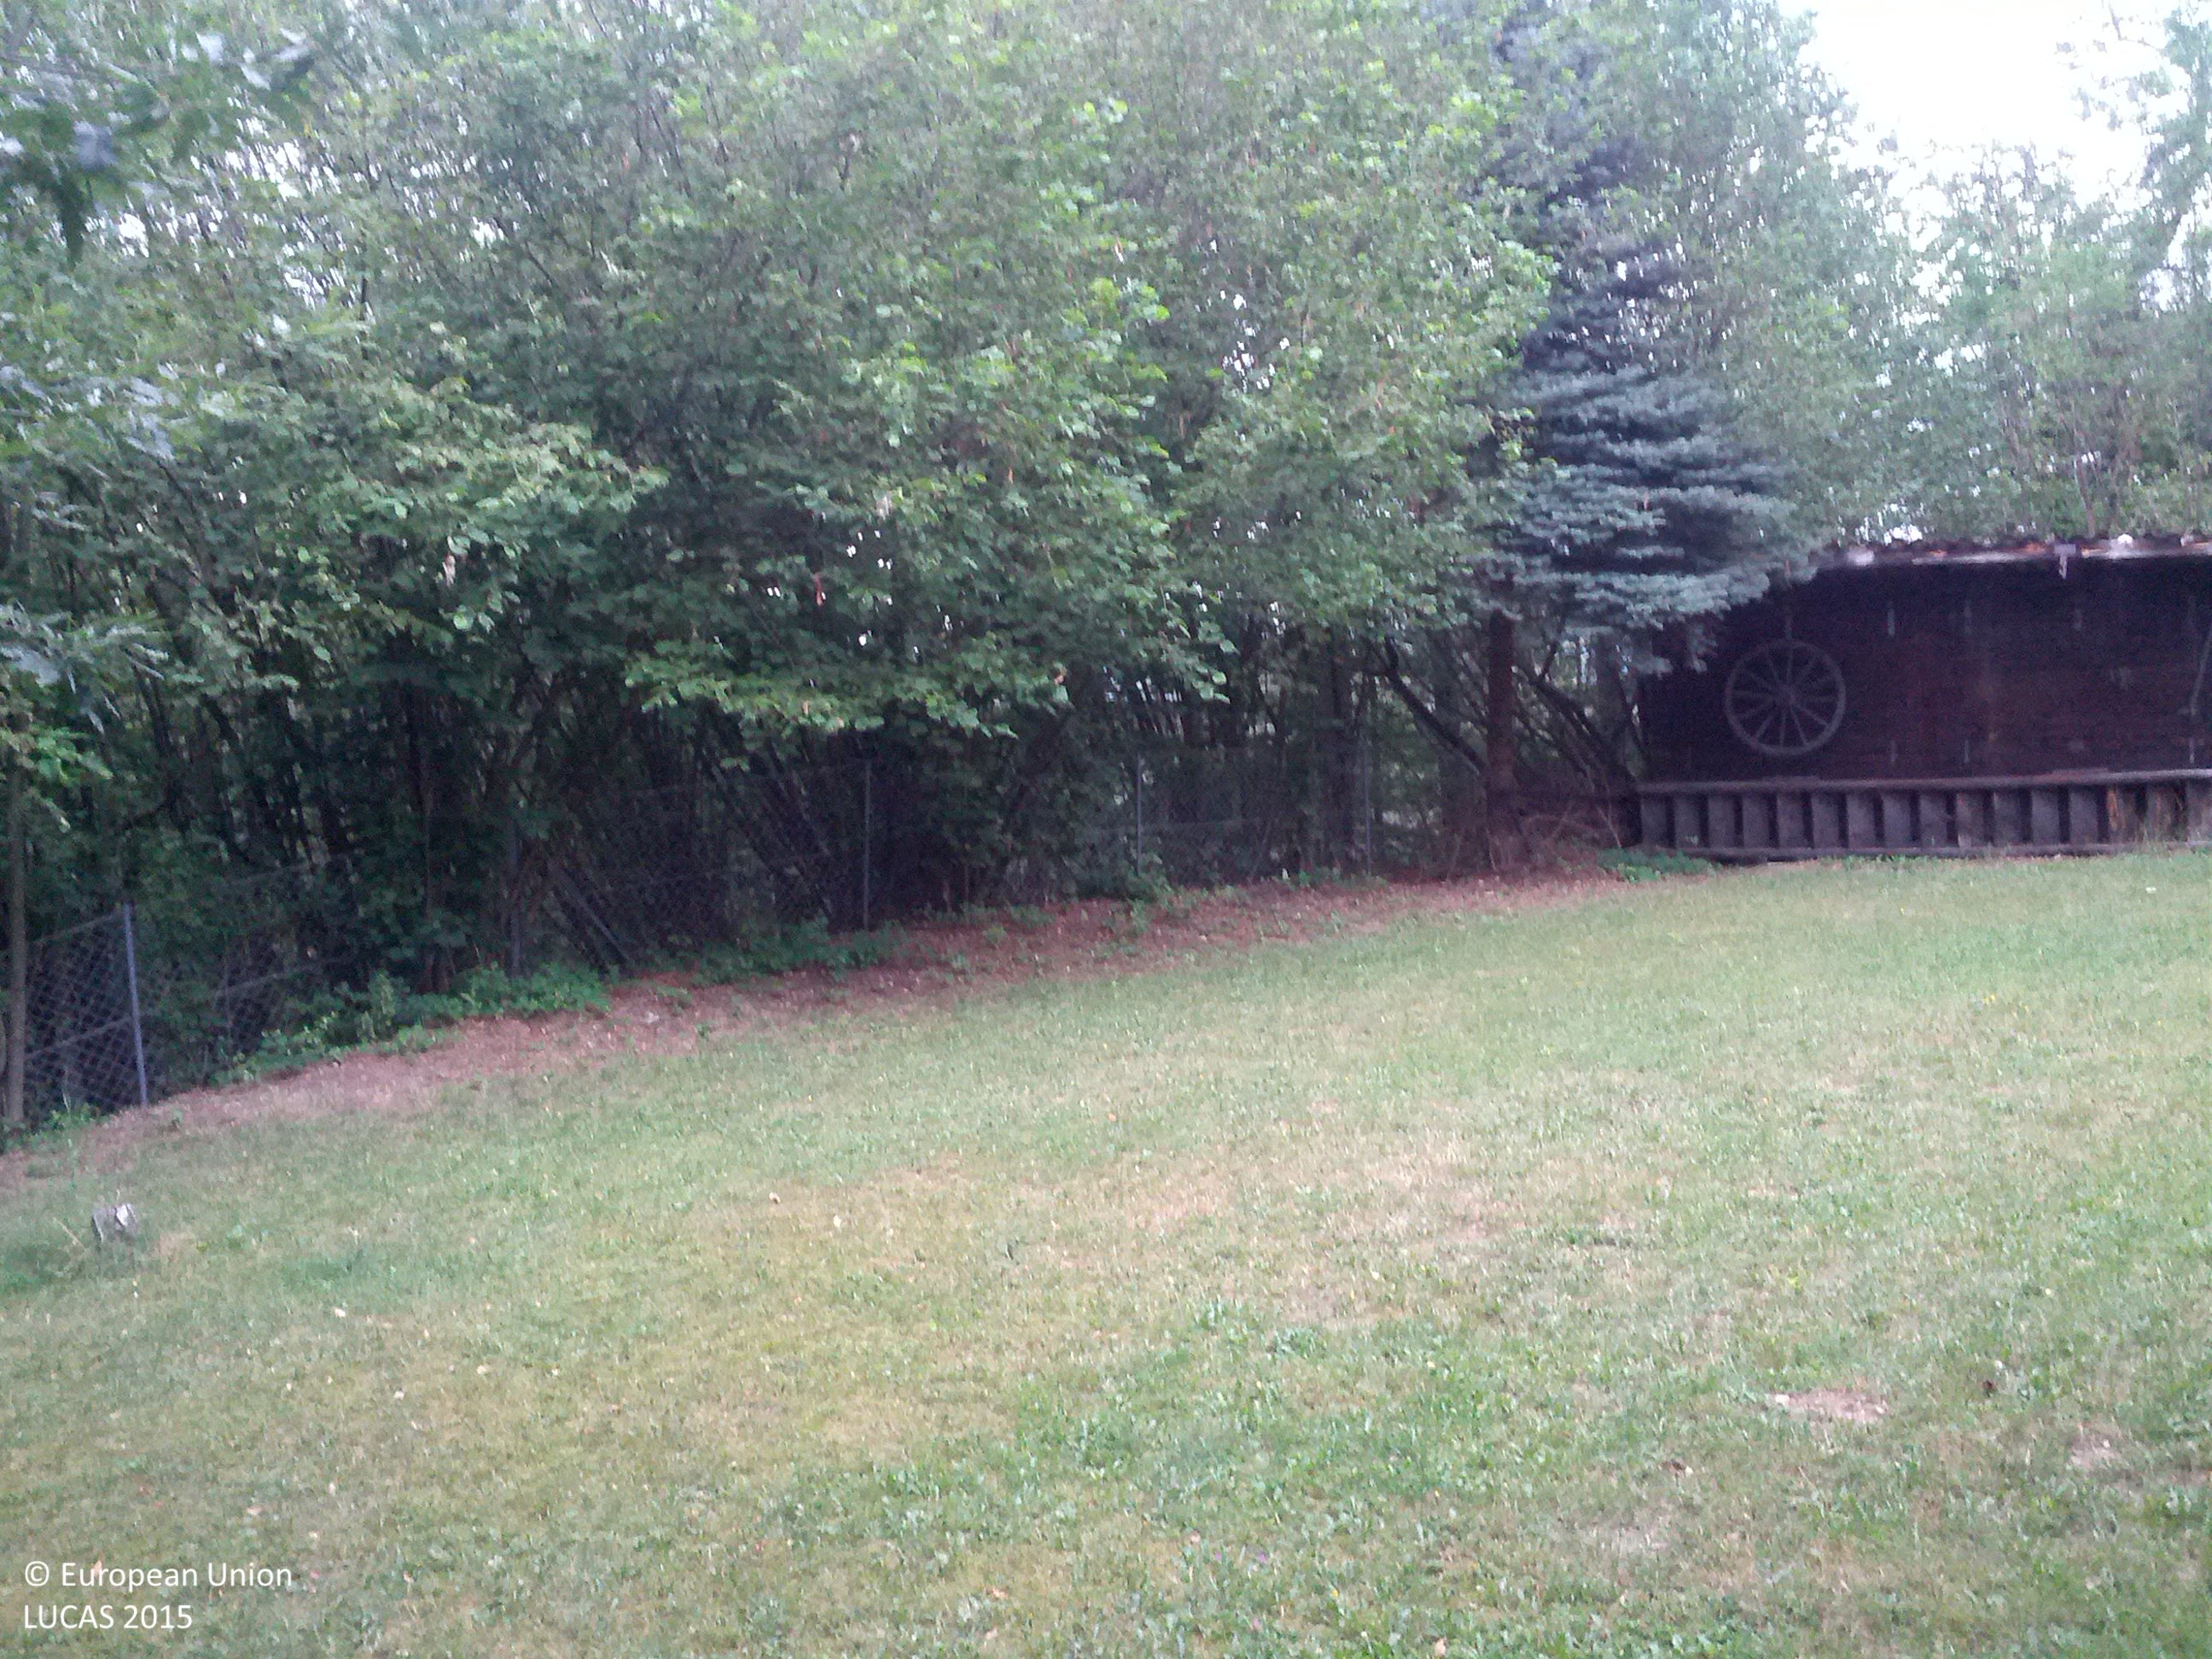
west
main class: Grassland
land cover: Grassland without tree/shrub cover
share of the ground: > 75 %
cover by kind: herbaceous plants 100 %
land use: Residential
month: July
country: AT
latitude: 47.4043
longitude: 16.1111
